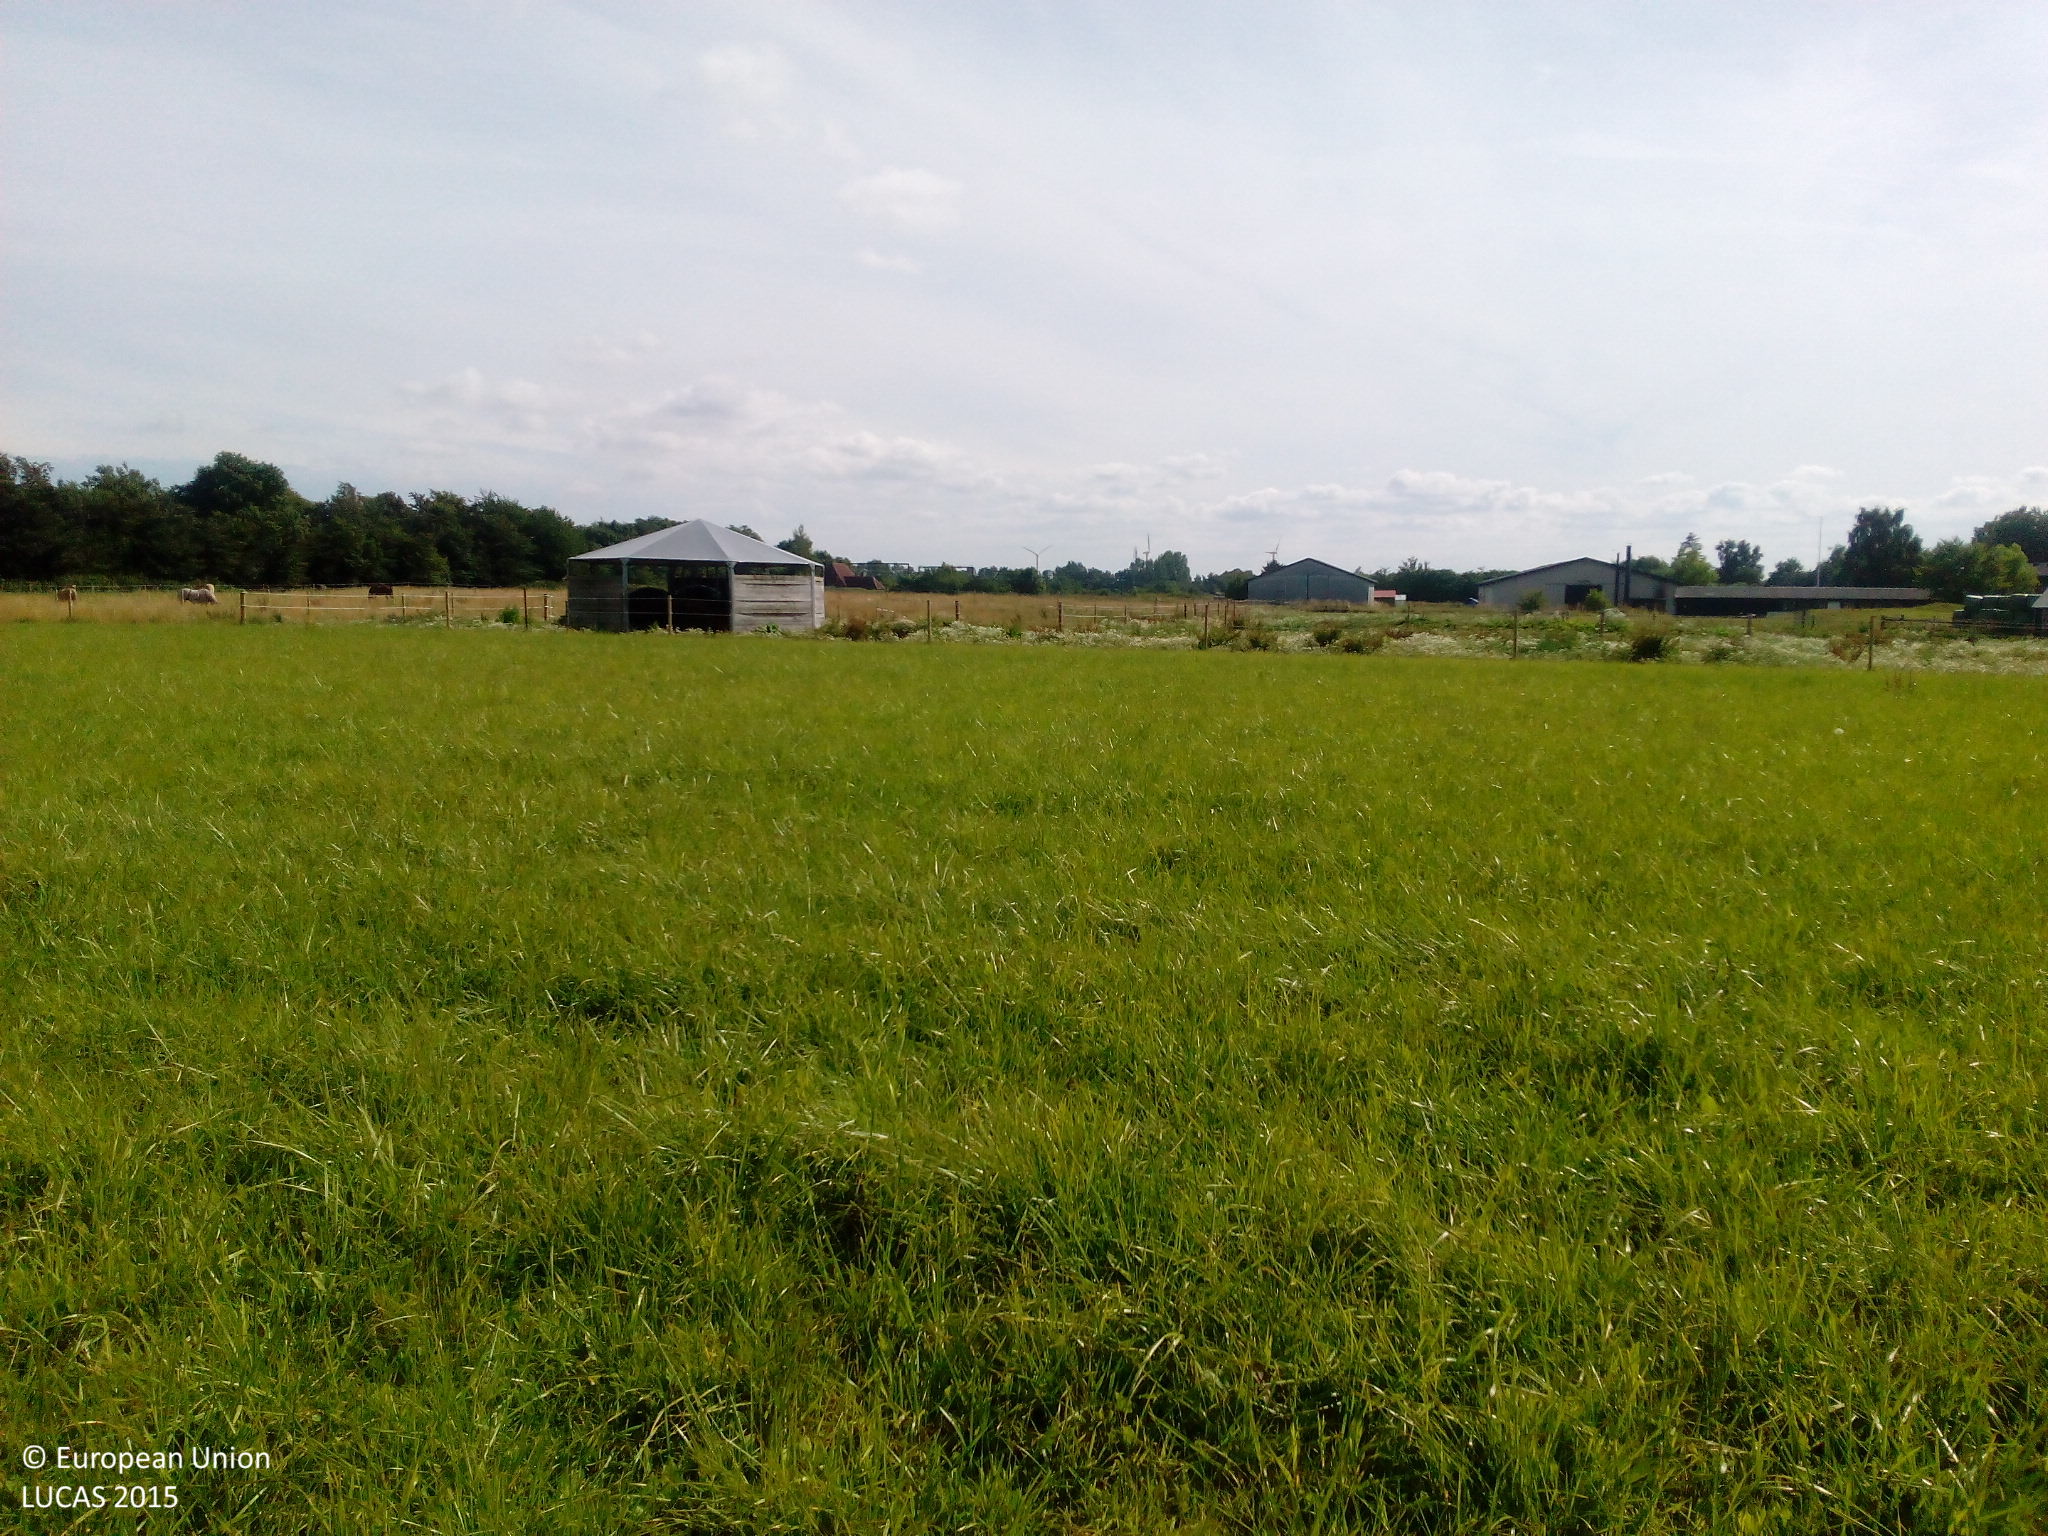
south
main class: Grassland
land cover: Grassland without tree/shrub cover
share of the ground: > 75 %
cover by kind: herbaceous plants 100 %
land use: Agriculture (excluding fallow land and kitchen gardens)
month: August
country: DK
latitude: 55.6140
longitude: 12.0464
